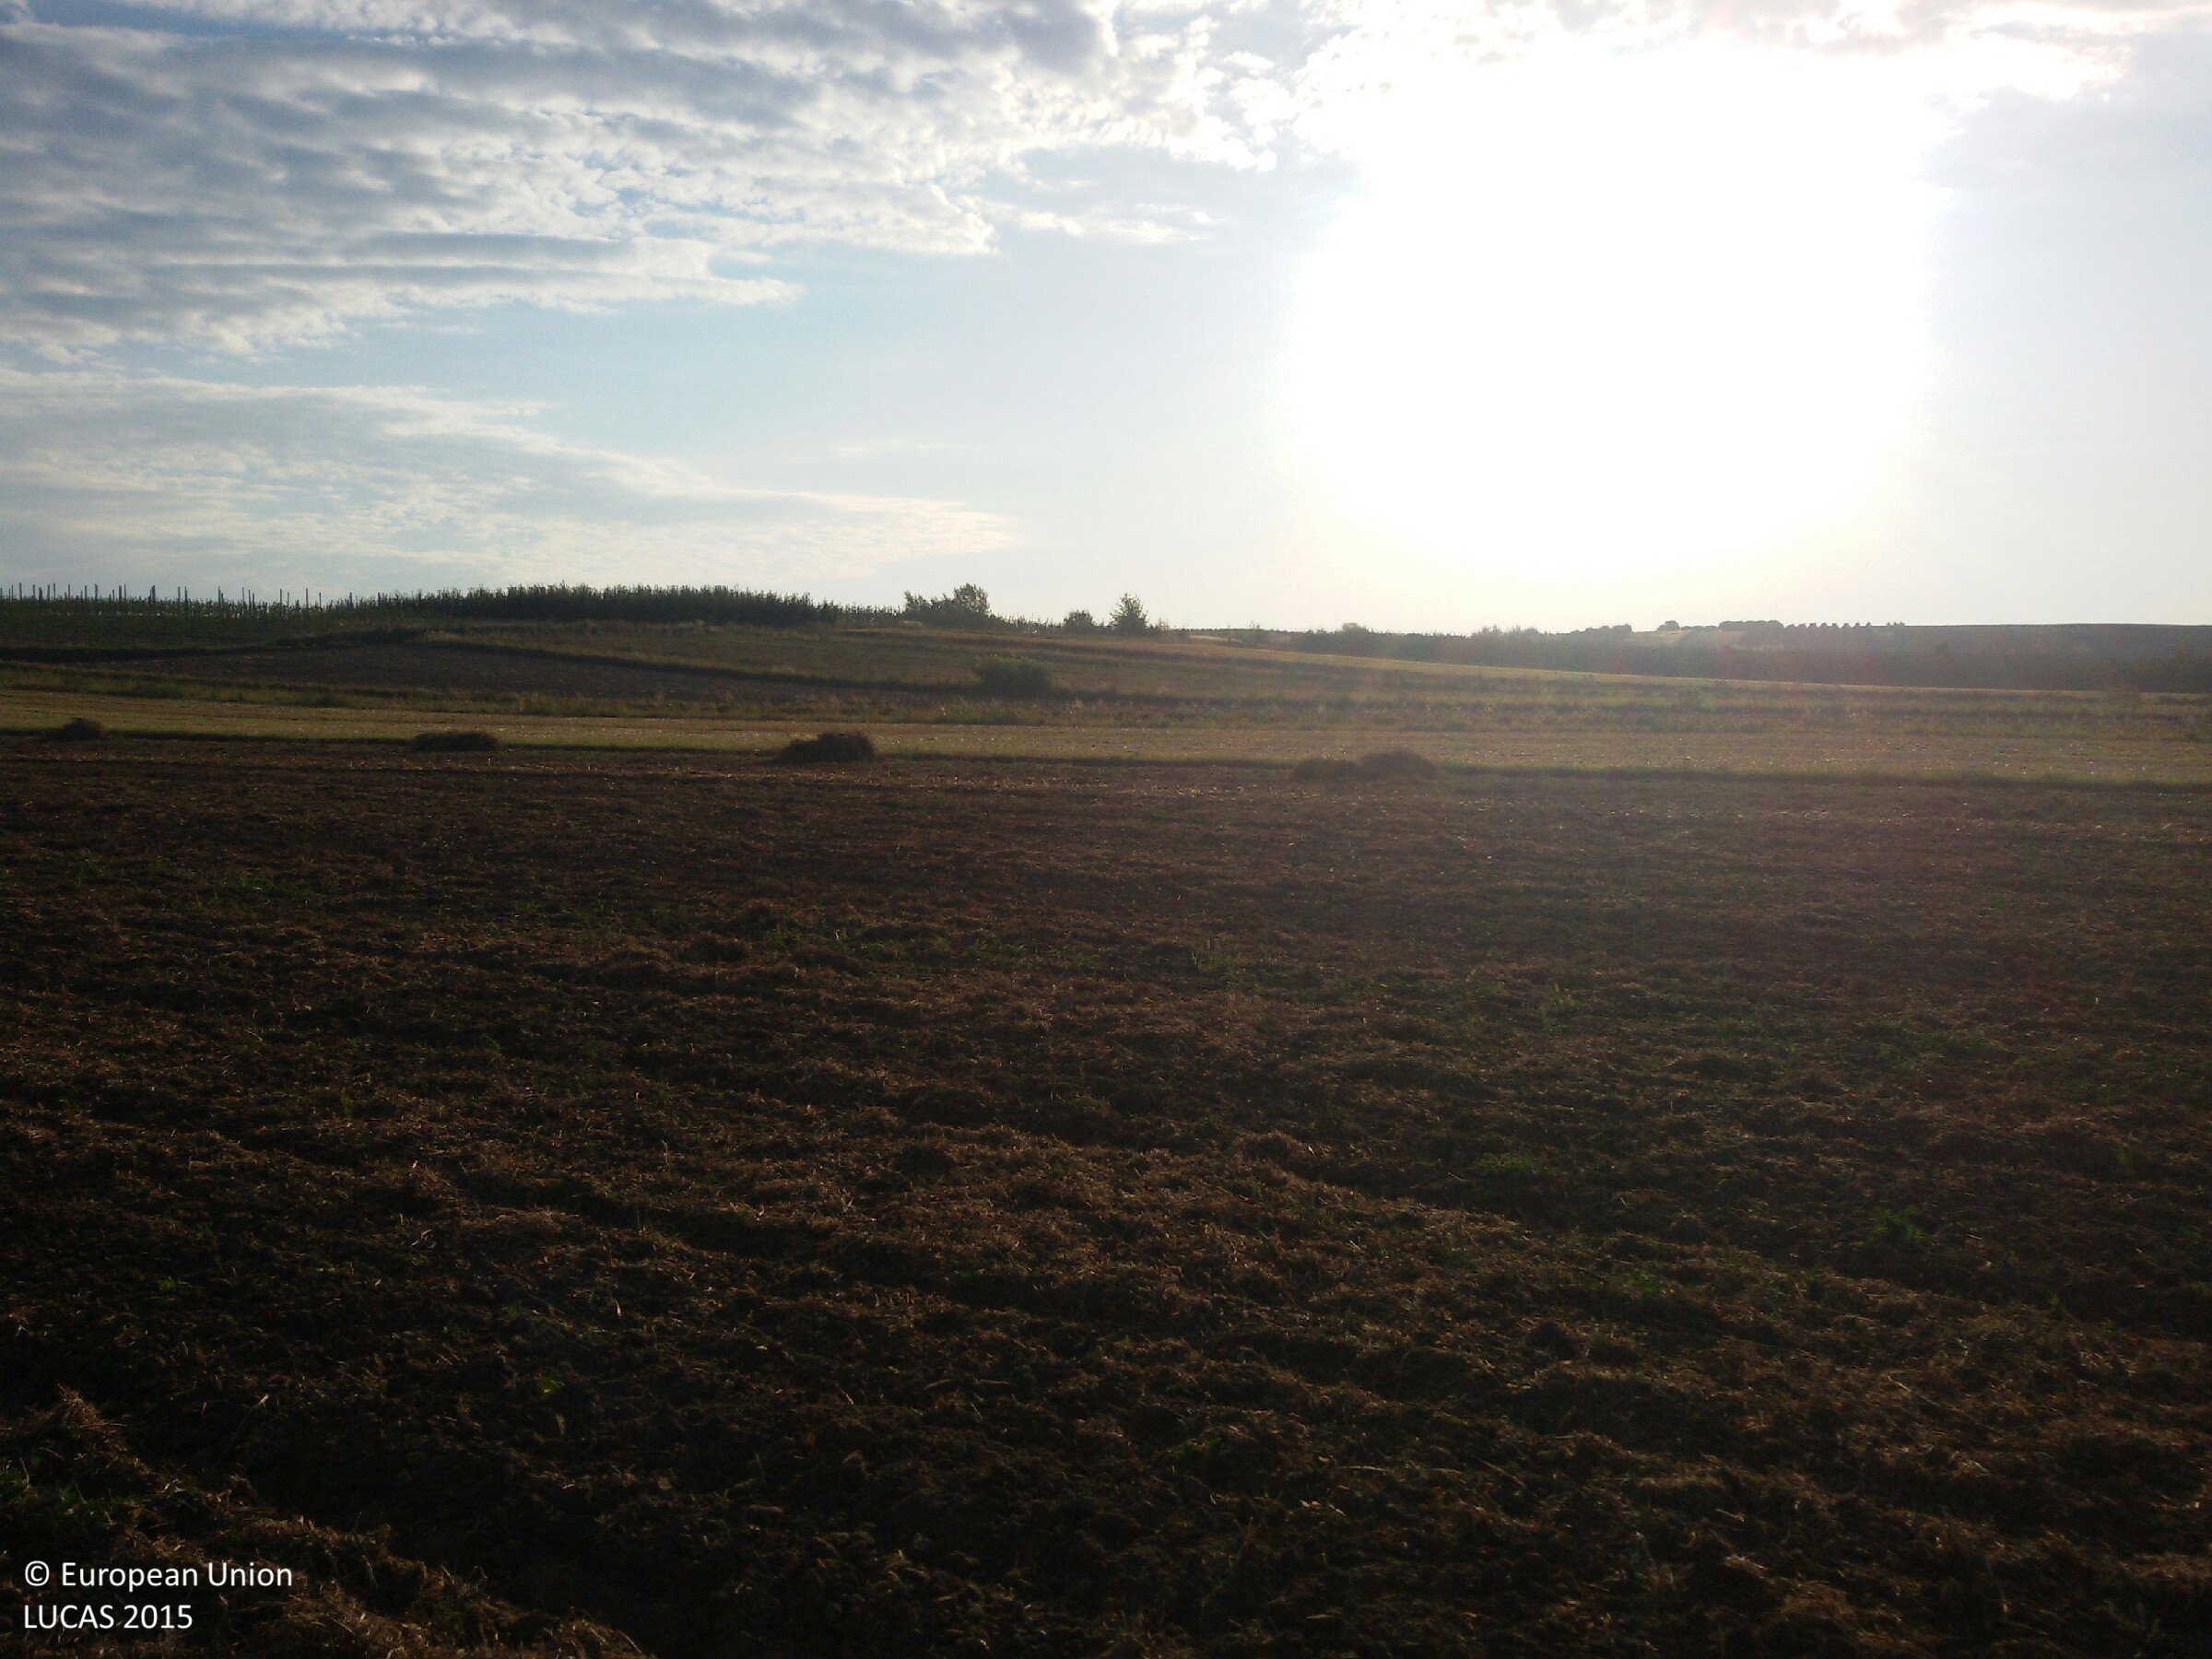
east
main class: Cropland
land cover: Other leguminous and mixtures for fodder
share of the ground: 10 - 25 %
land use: Agriculture (excluding fallow land and kitchen gardens)
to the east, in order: Other leguminous and mixtures for fodder; Grass margins; Common wheat; Grass margins; Potatoes; Grass margins; Other bare soil; Grass margins; Potatoes; Grass margins; Other leguminous and mixtures for fodder; Grass margins; Other cereals; Common wheat
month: August
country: PL
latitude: 50.7437
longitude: 21.6884
